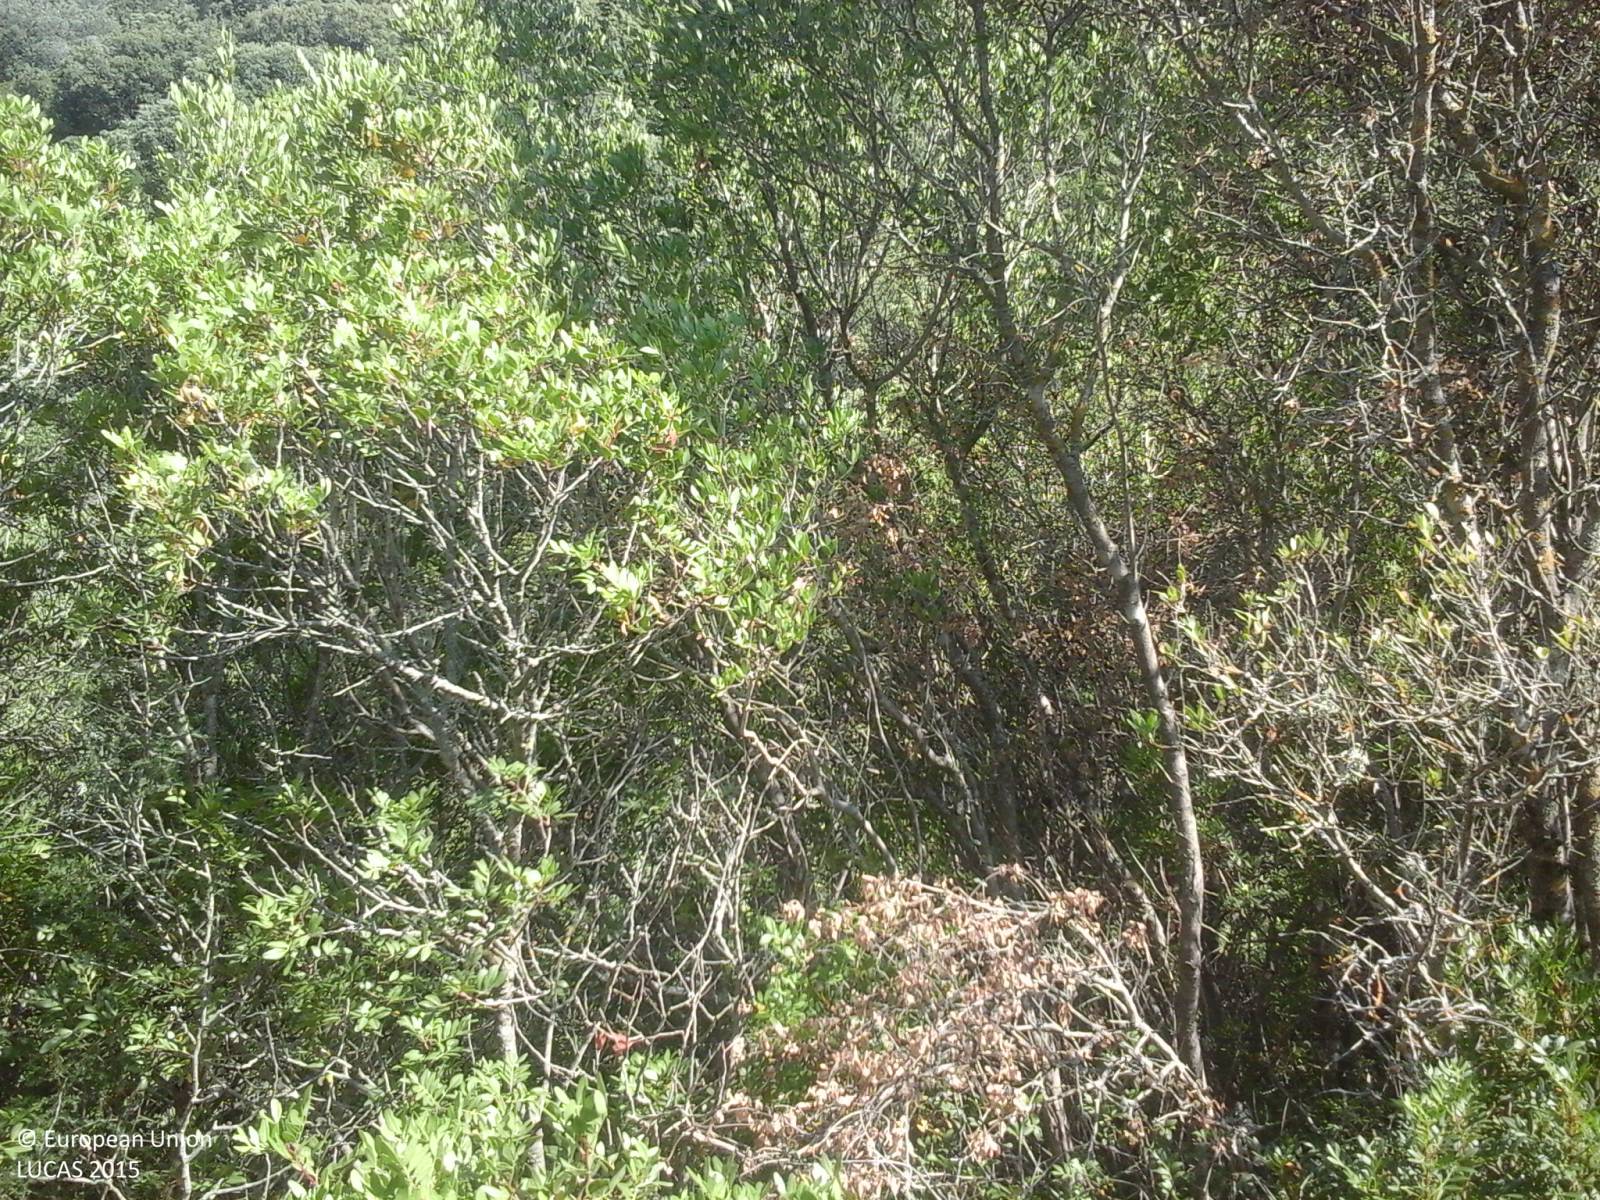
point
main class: Shrubland
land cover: Shrubland with sparse tree cover
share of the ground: > 75 %
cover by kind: shrubs 95 %, broadleaved forest trees 5 %
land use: Semi-natural and natural areas not in use
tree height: > 5 m
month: July
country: IT
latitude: 40.7903
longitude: 9.3985
